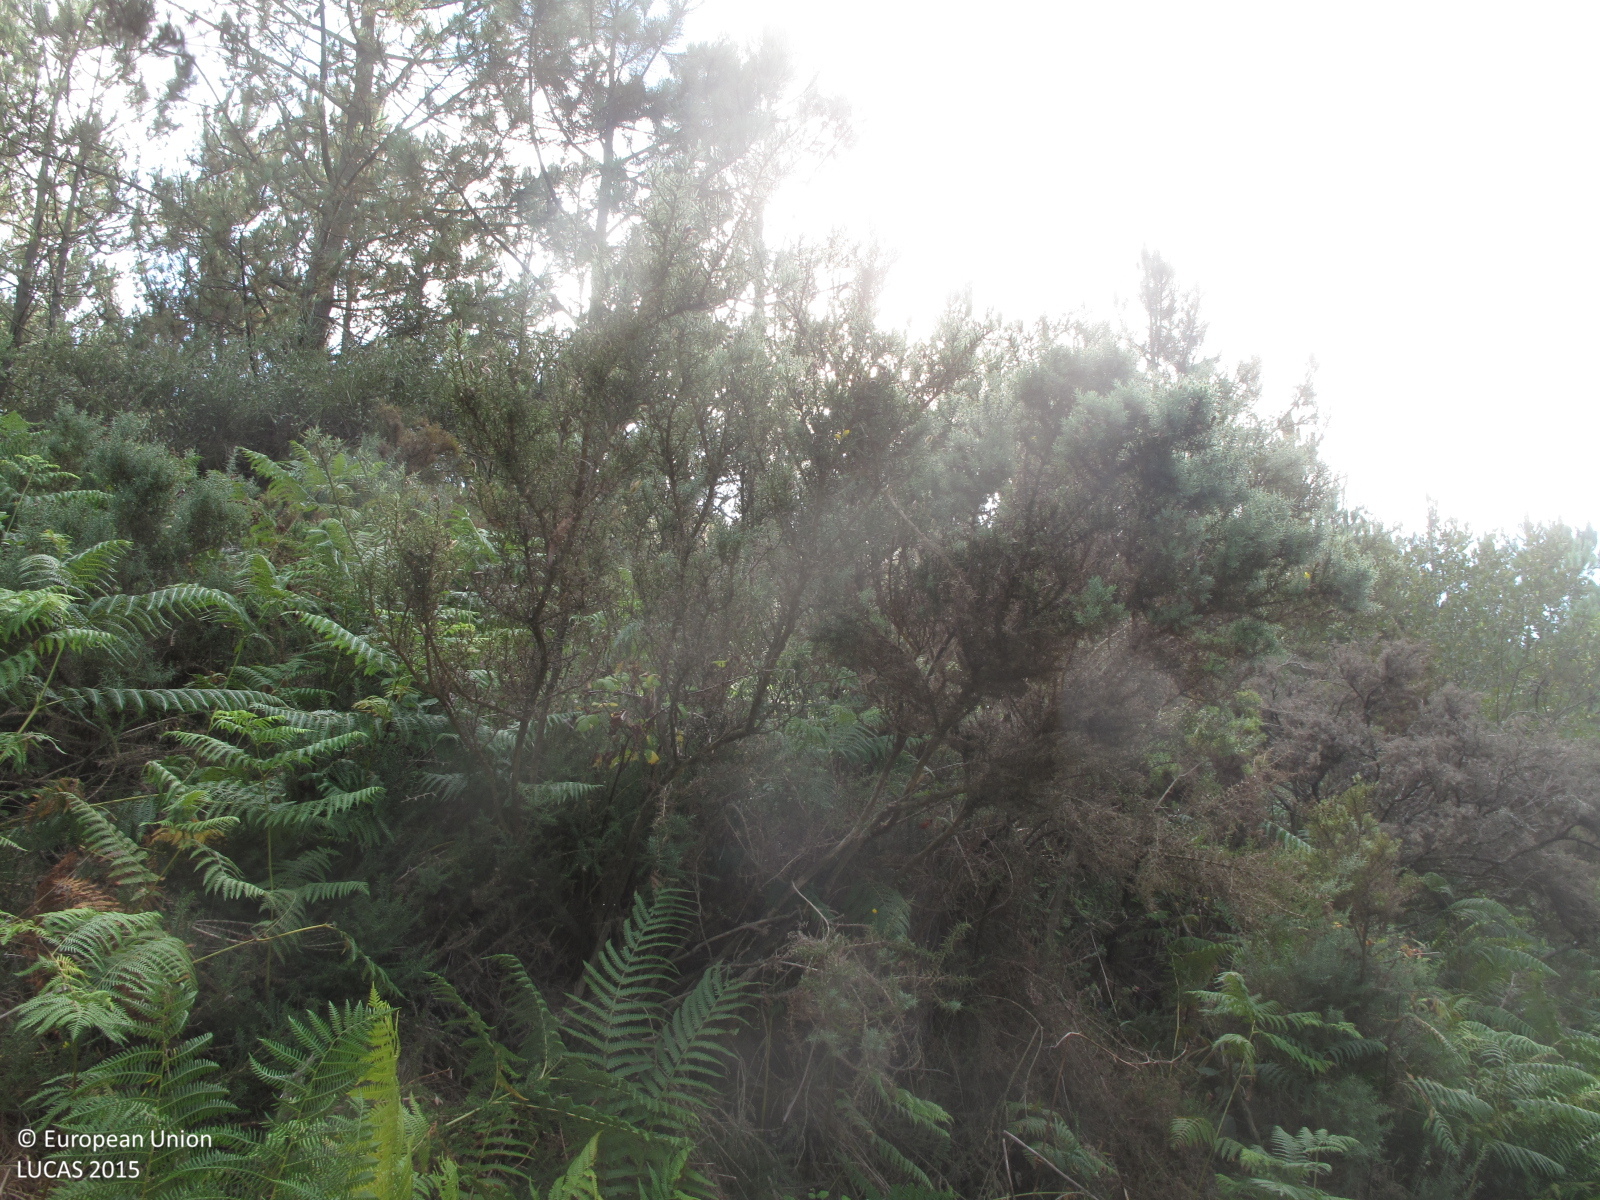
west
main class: Woodland
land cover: Pine dominated coniferous woodland
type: hemiboreal forest and nemoral coniferous forest and mixed broadleaved-coniferous forest
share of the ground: 50 - 75 %
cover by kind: coniferous forest trees 60 %, shrubs 20 %, herbaceous plants 20 %
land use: Forestry
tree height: > 5 m
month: July
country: ES
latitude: 42.9602
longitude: -9.1133
